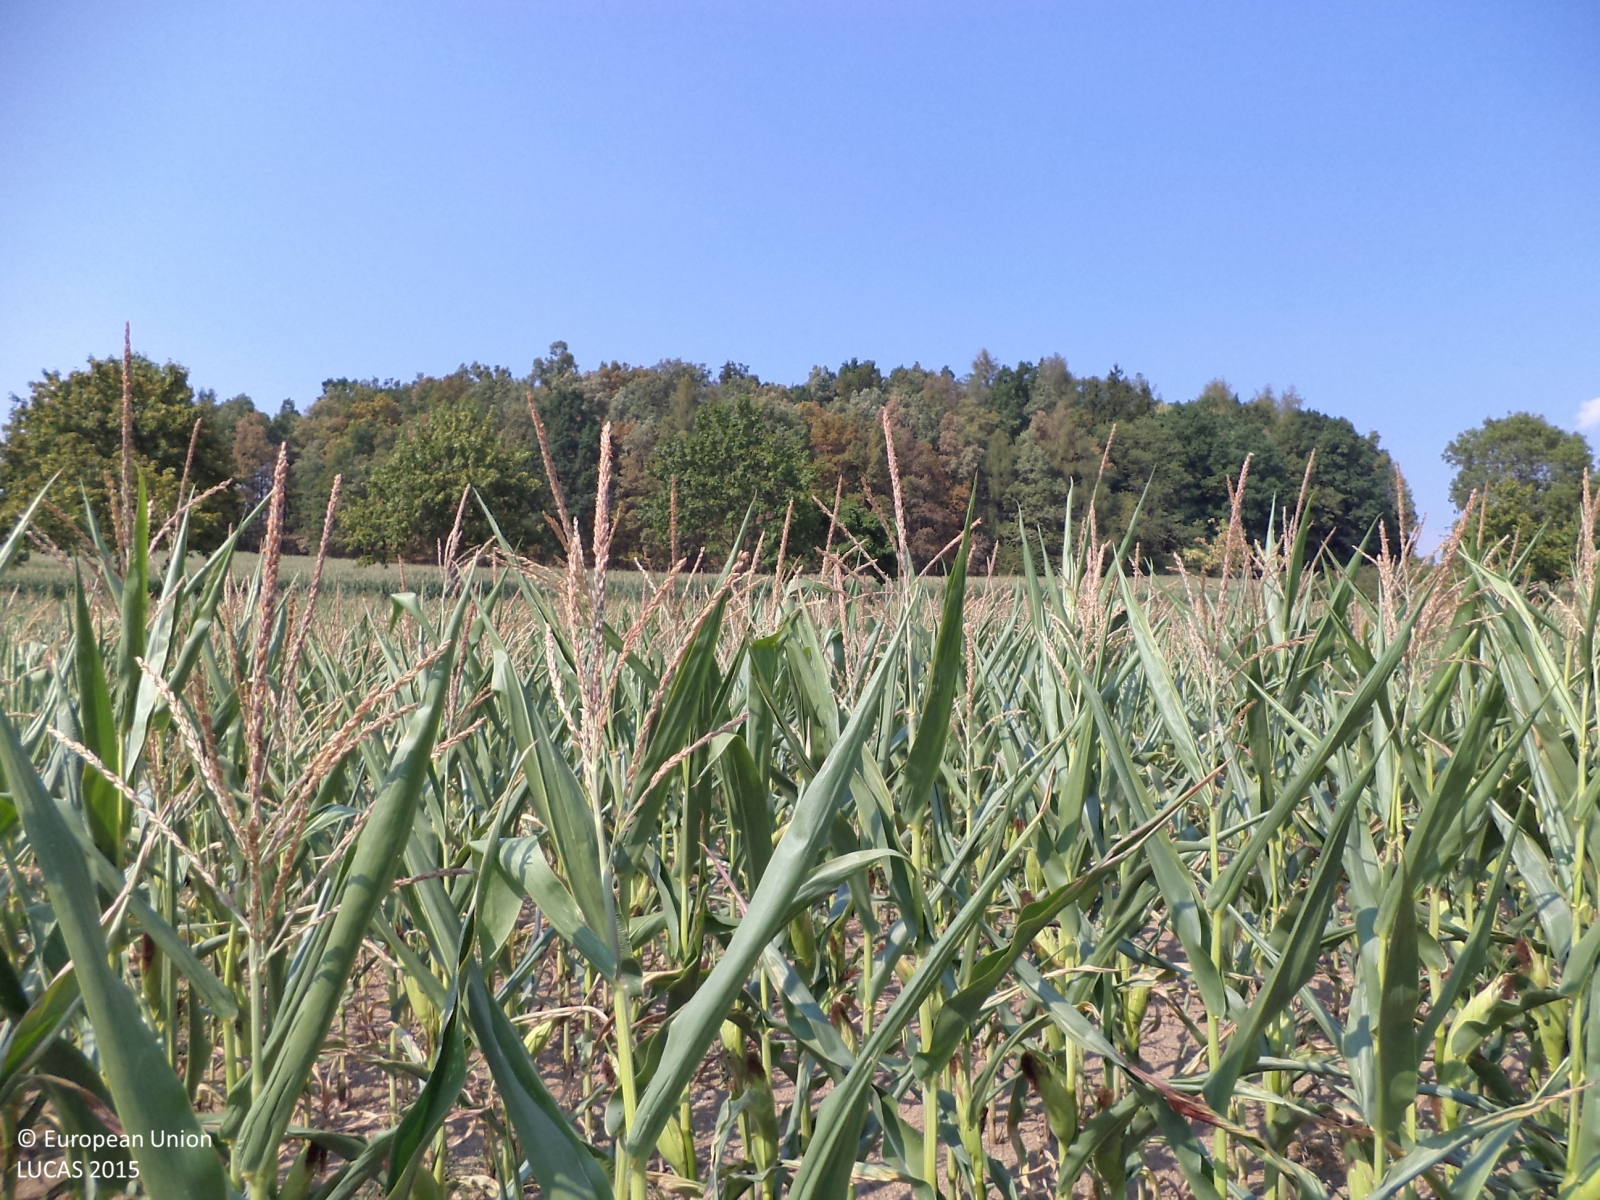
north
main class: Cropland
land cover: Maize
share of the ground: > 75 %
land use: Agriculture (excluding fallow land and kitchen gardens)
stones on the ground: < 10 %
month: August
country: CZ
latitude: 49.5238
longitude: 14.3805
